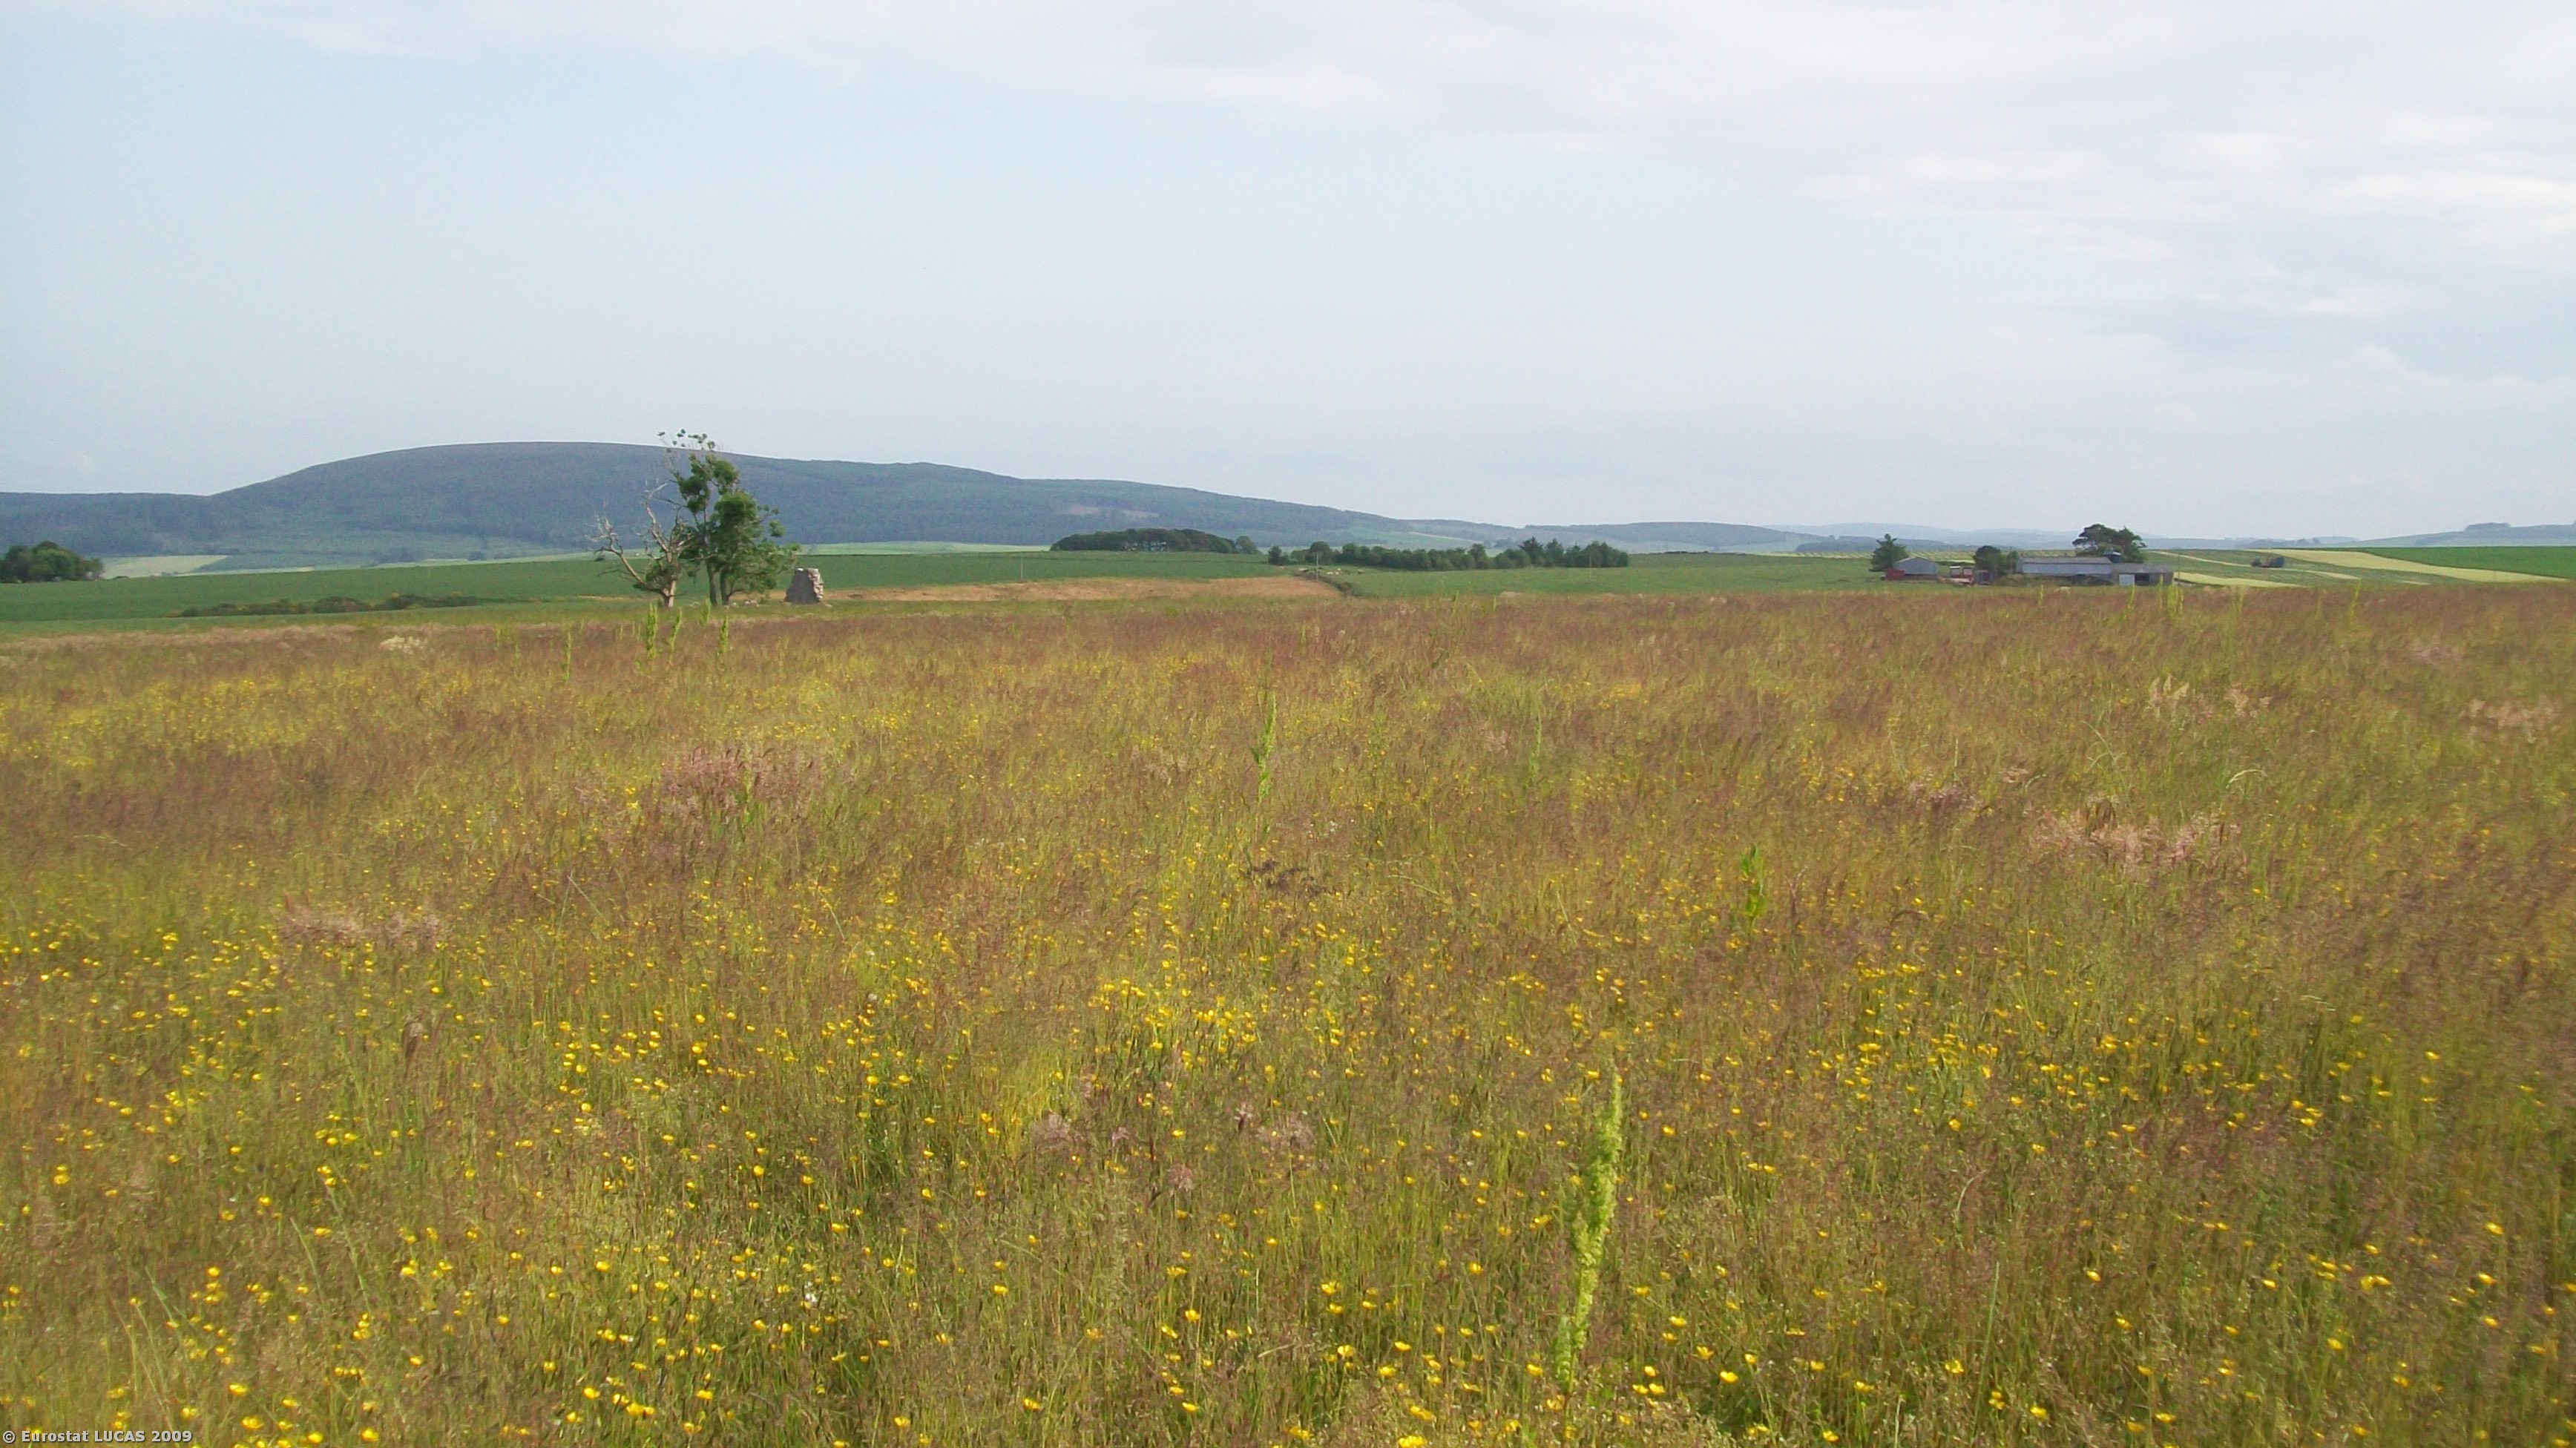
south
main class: Grassland
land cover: Grassland without tree/shrub cover
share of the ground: > 75 %
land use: Fallow land
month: June
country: GB
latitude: 57.5744
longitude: -2.9180
